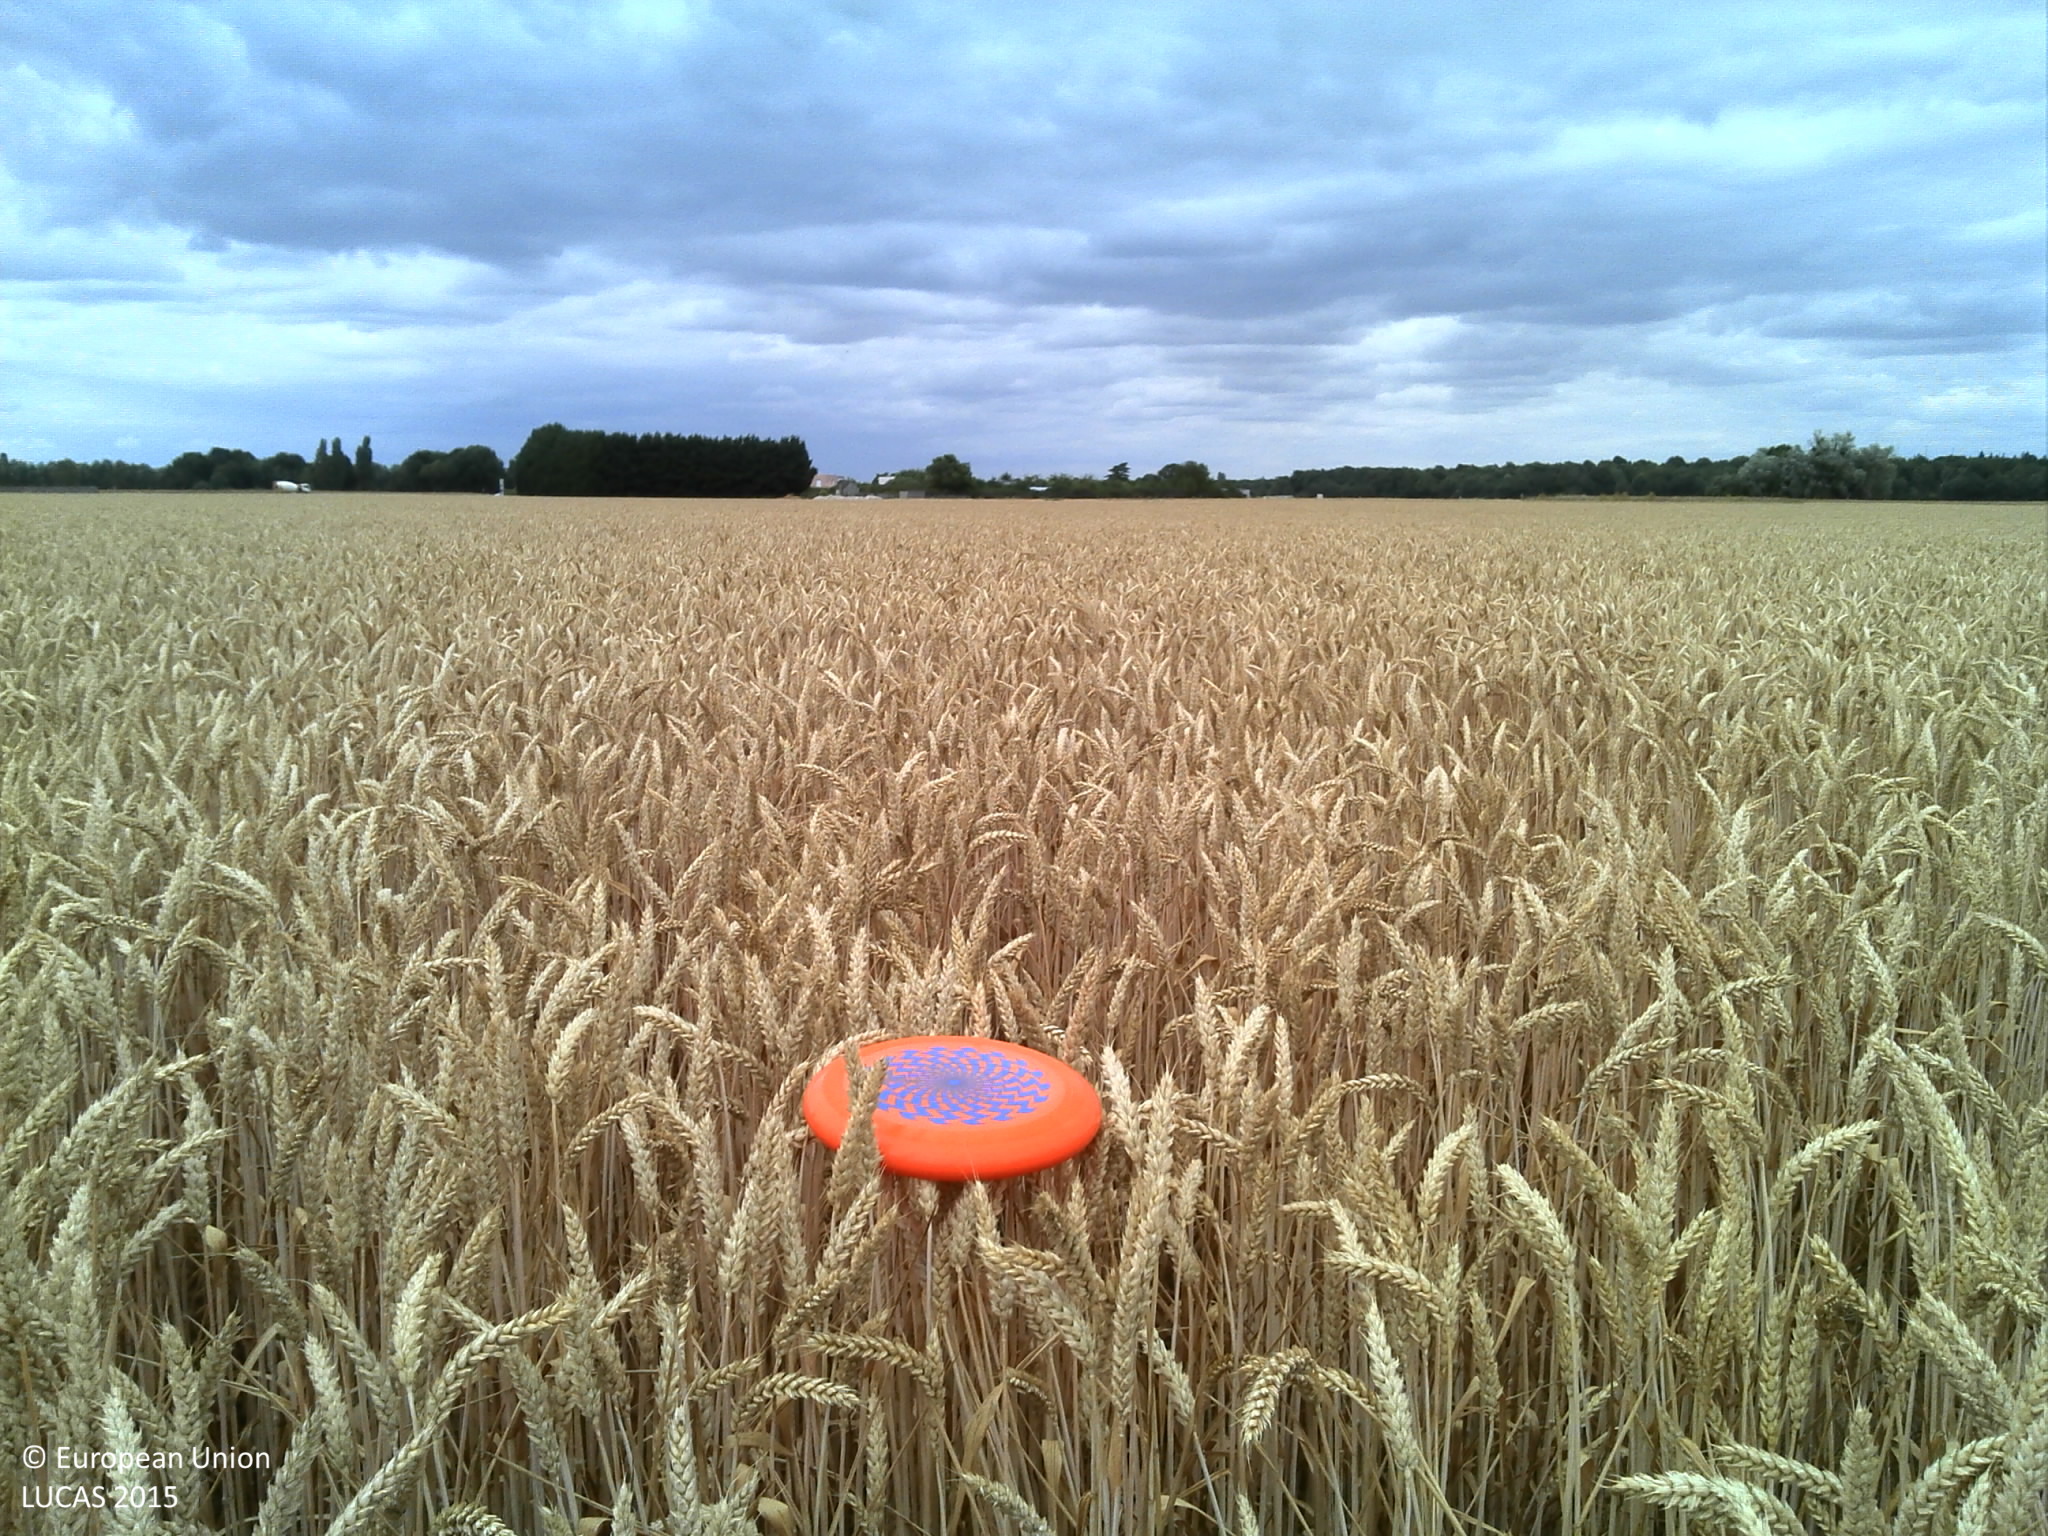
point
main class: Cropland
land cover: Common wheat
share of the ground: > 75 %
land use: Agriculture (excluding fallow land and kitchen gardens)
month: July
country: FR
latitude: 48.5245
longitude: 2.4471
